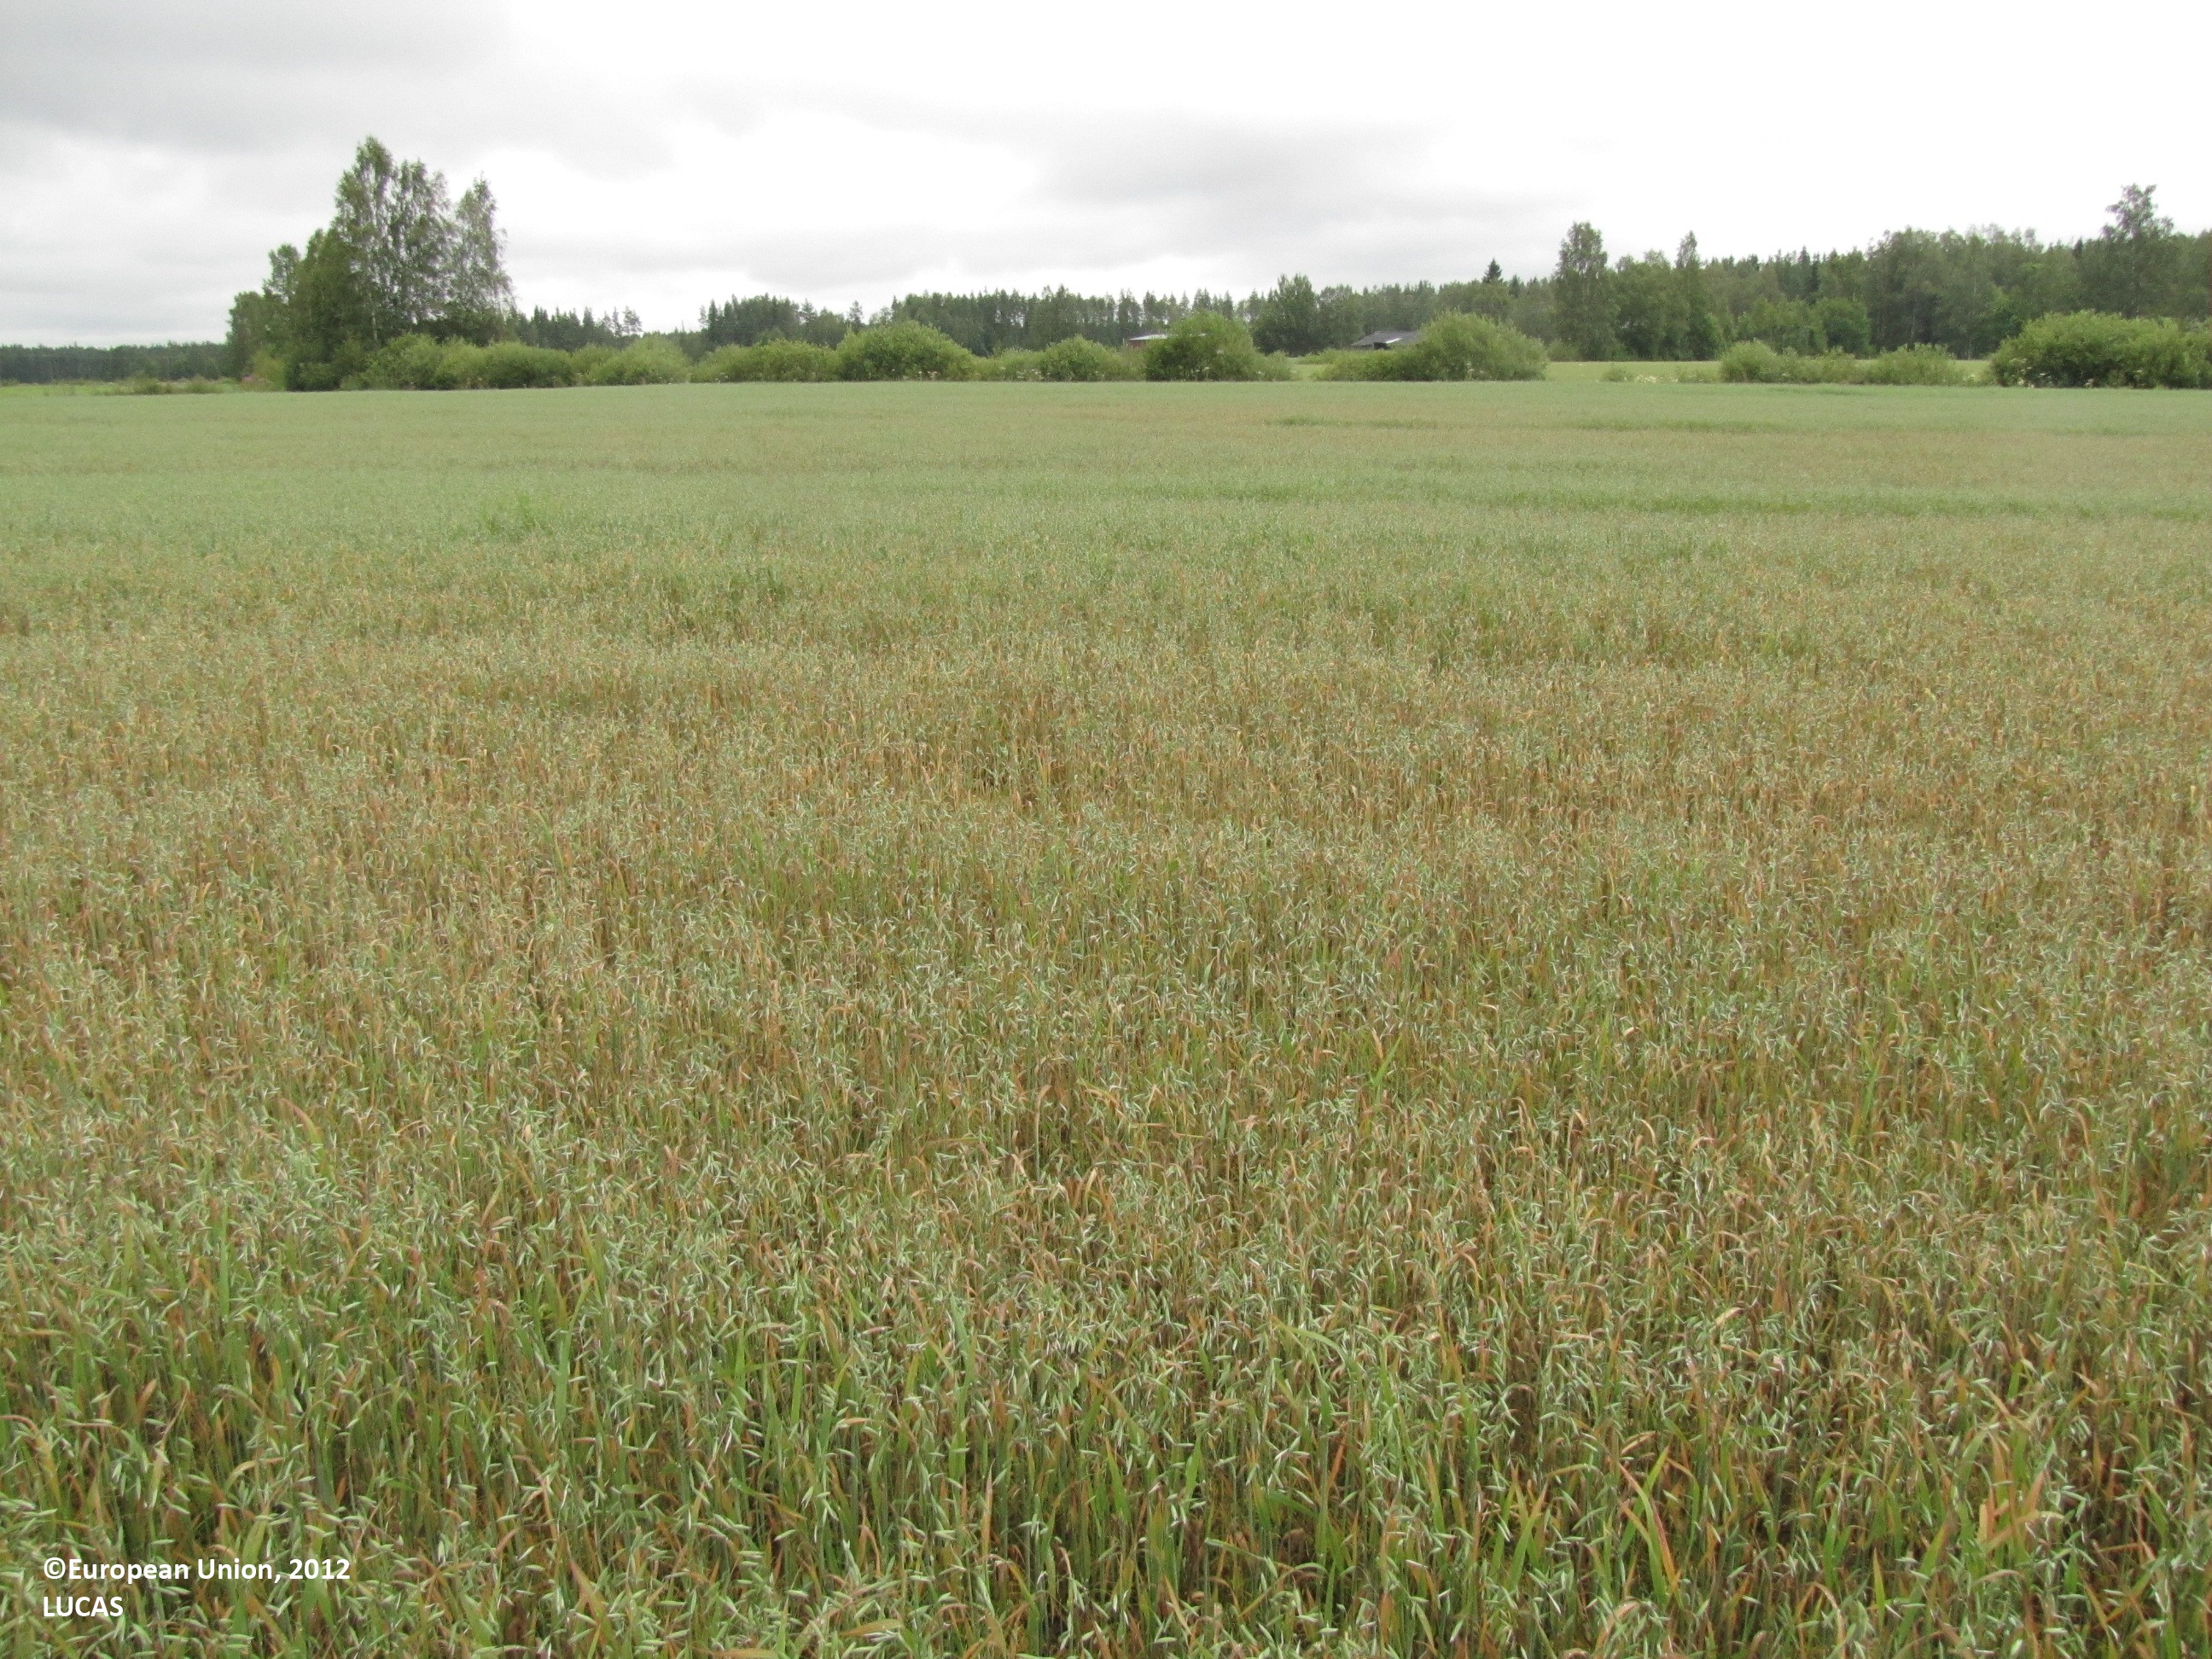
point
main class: Cropland
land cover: Oats
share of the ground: > 75 %
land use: Agriculture (excluding fallow land and kitchen gardens)
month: July
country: FI
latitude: 62.1926
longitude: 22.9973
